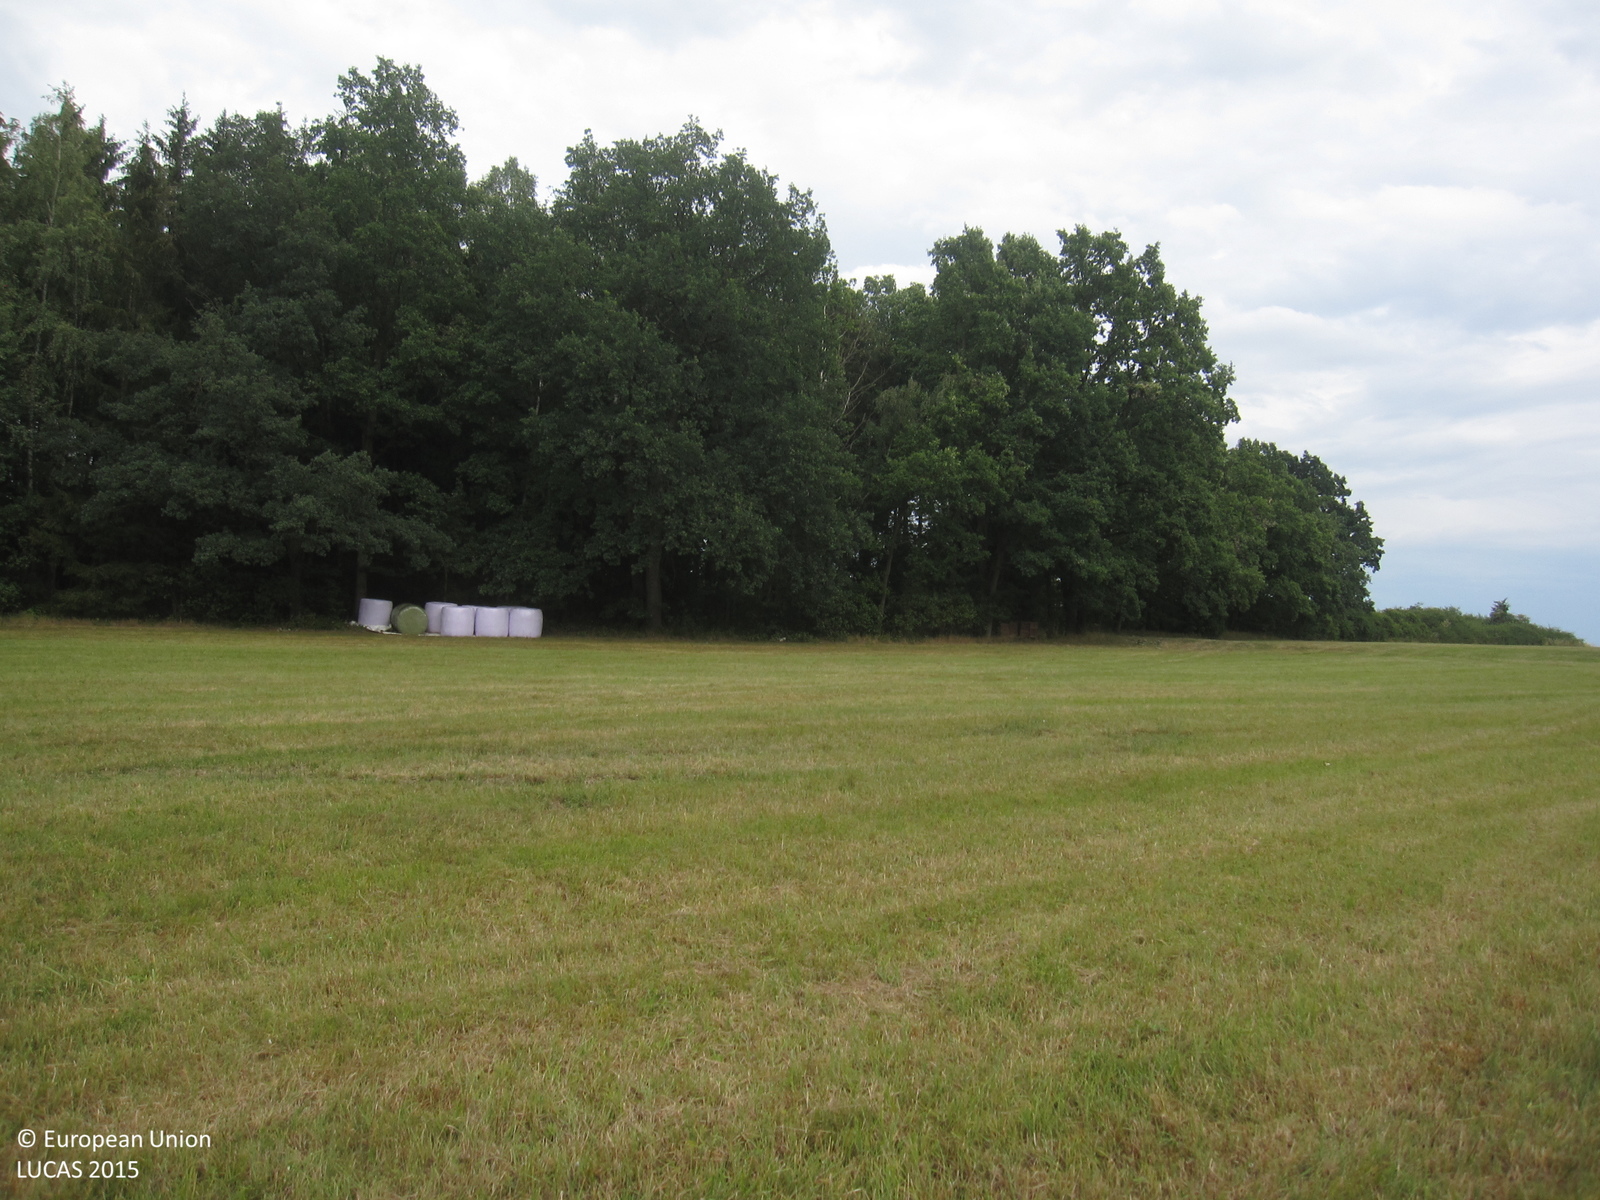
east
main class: Grassland
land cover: Grassland without tree/shrub cover
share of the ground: > 75 %
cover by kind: herbaceous plants 95 %, unconsolidated bare surface 5 %
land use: Agriculture (excluding fallow land and kitchen gardens)
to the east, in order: Grassland without tree/shrub cover; Broadleaved woodland; Artificial constructions in urban areas; Rape and turnip rape
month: August
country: DE
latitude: 50.5426
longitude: 12.1022
